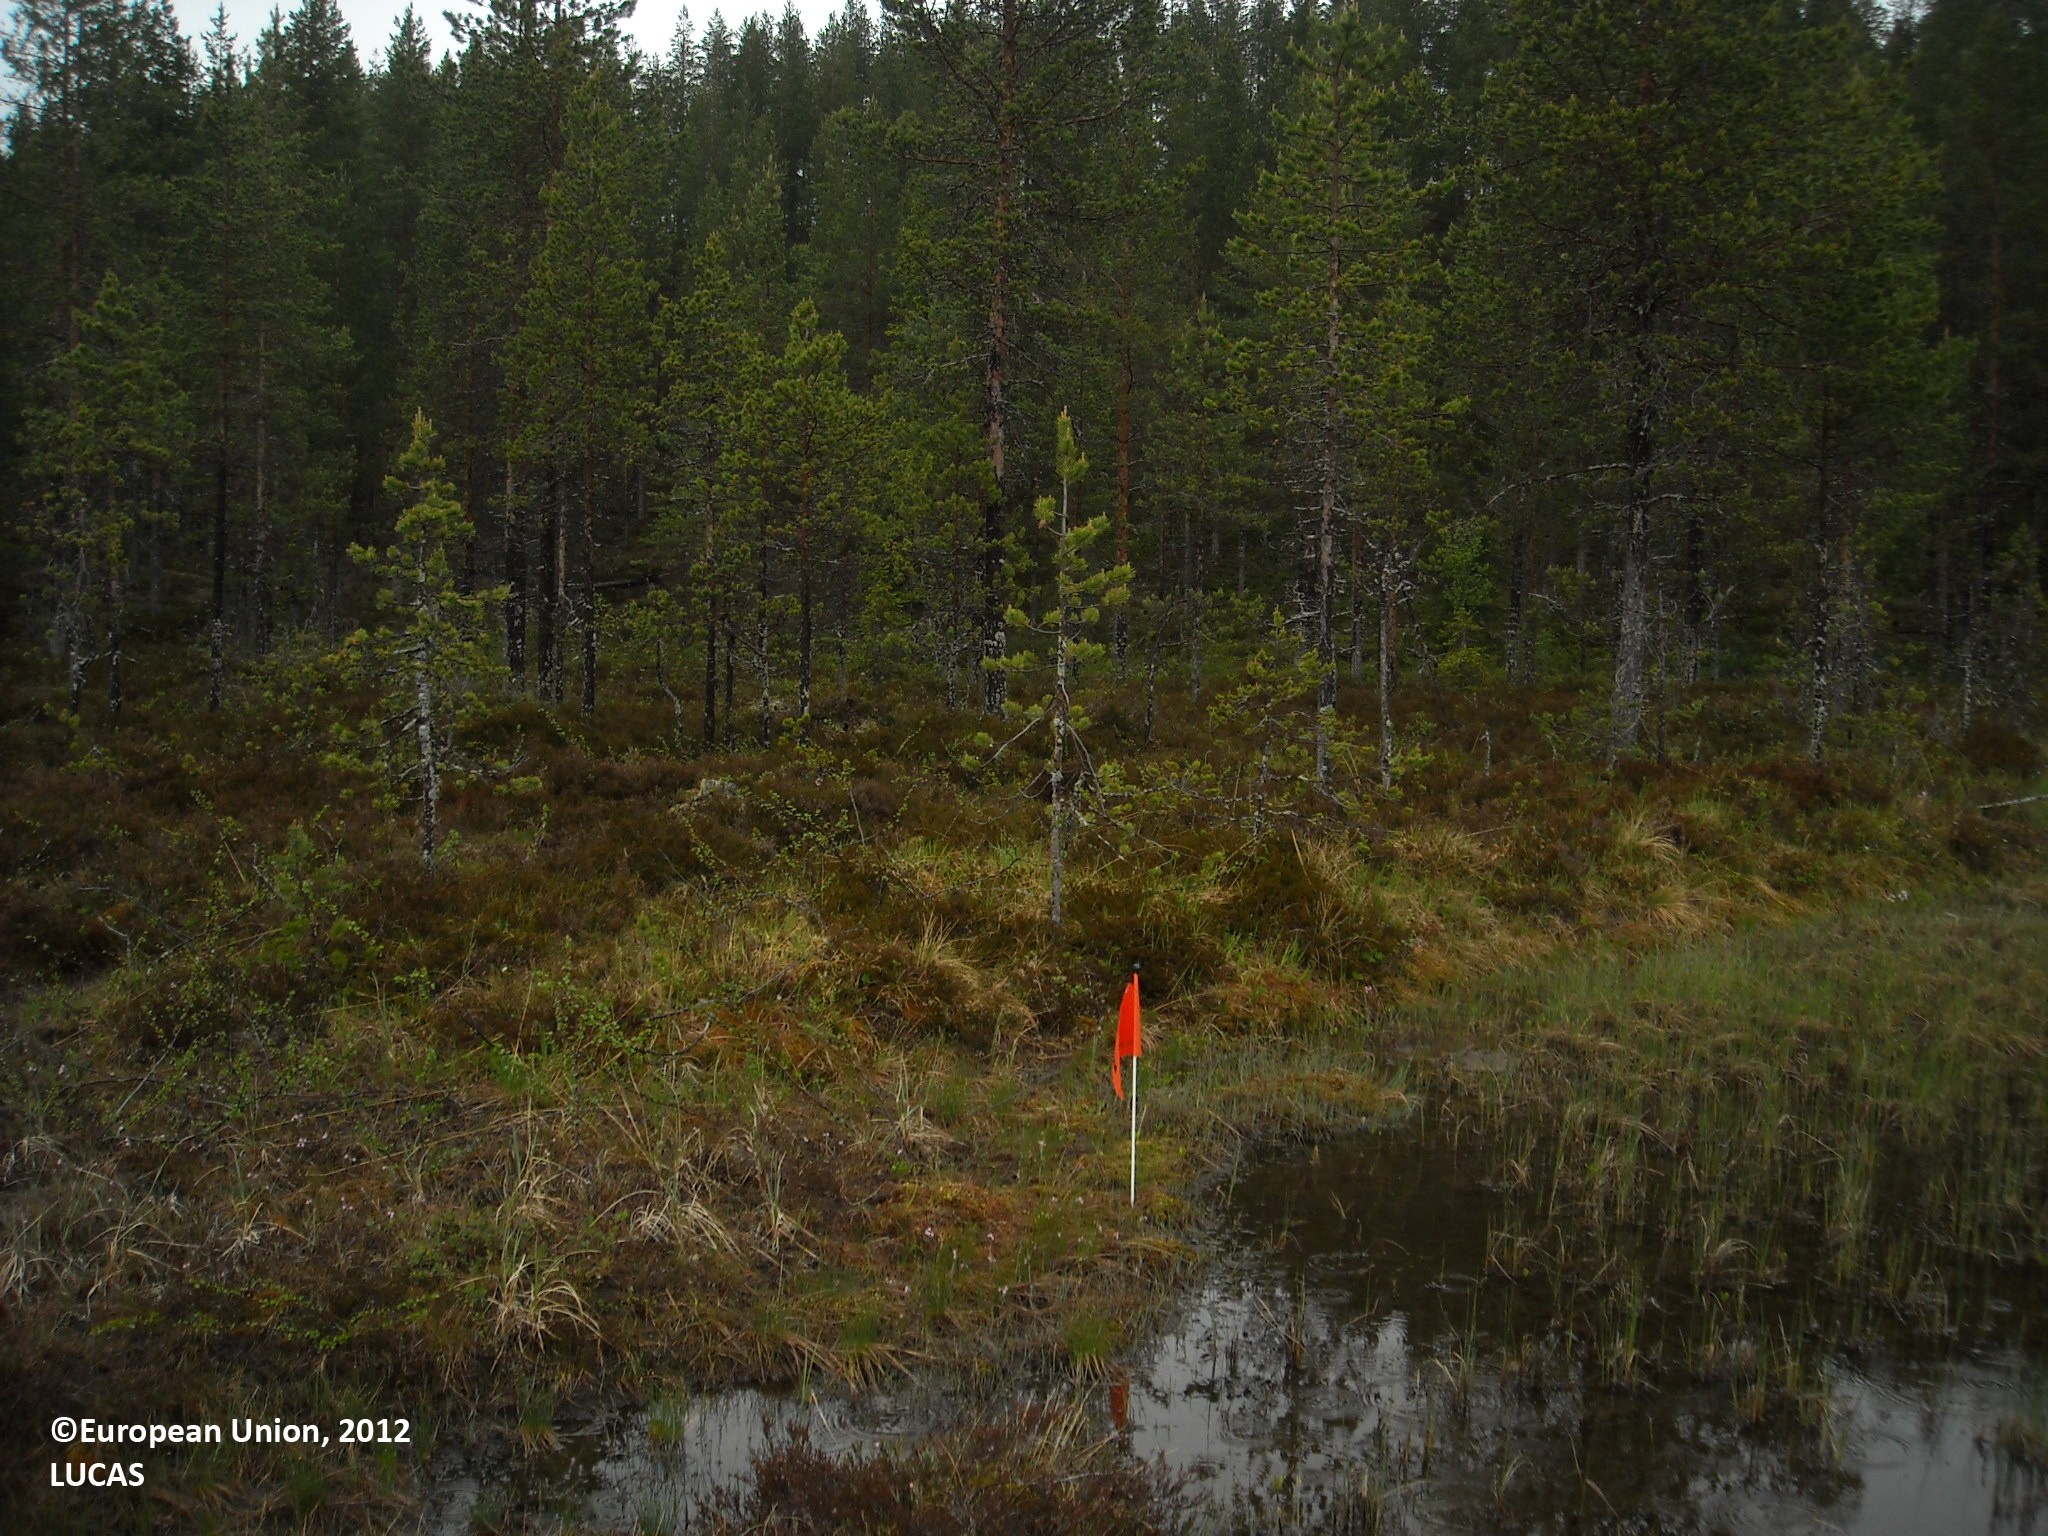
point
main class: Woodland
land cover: Pine dominated coniferous woodland
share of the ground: 25 - 50 %
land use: Semi-natural and natural areas not in use
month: June
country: FI
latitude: 65.5688
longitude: 27.8865
